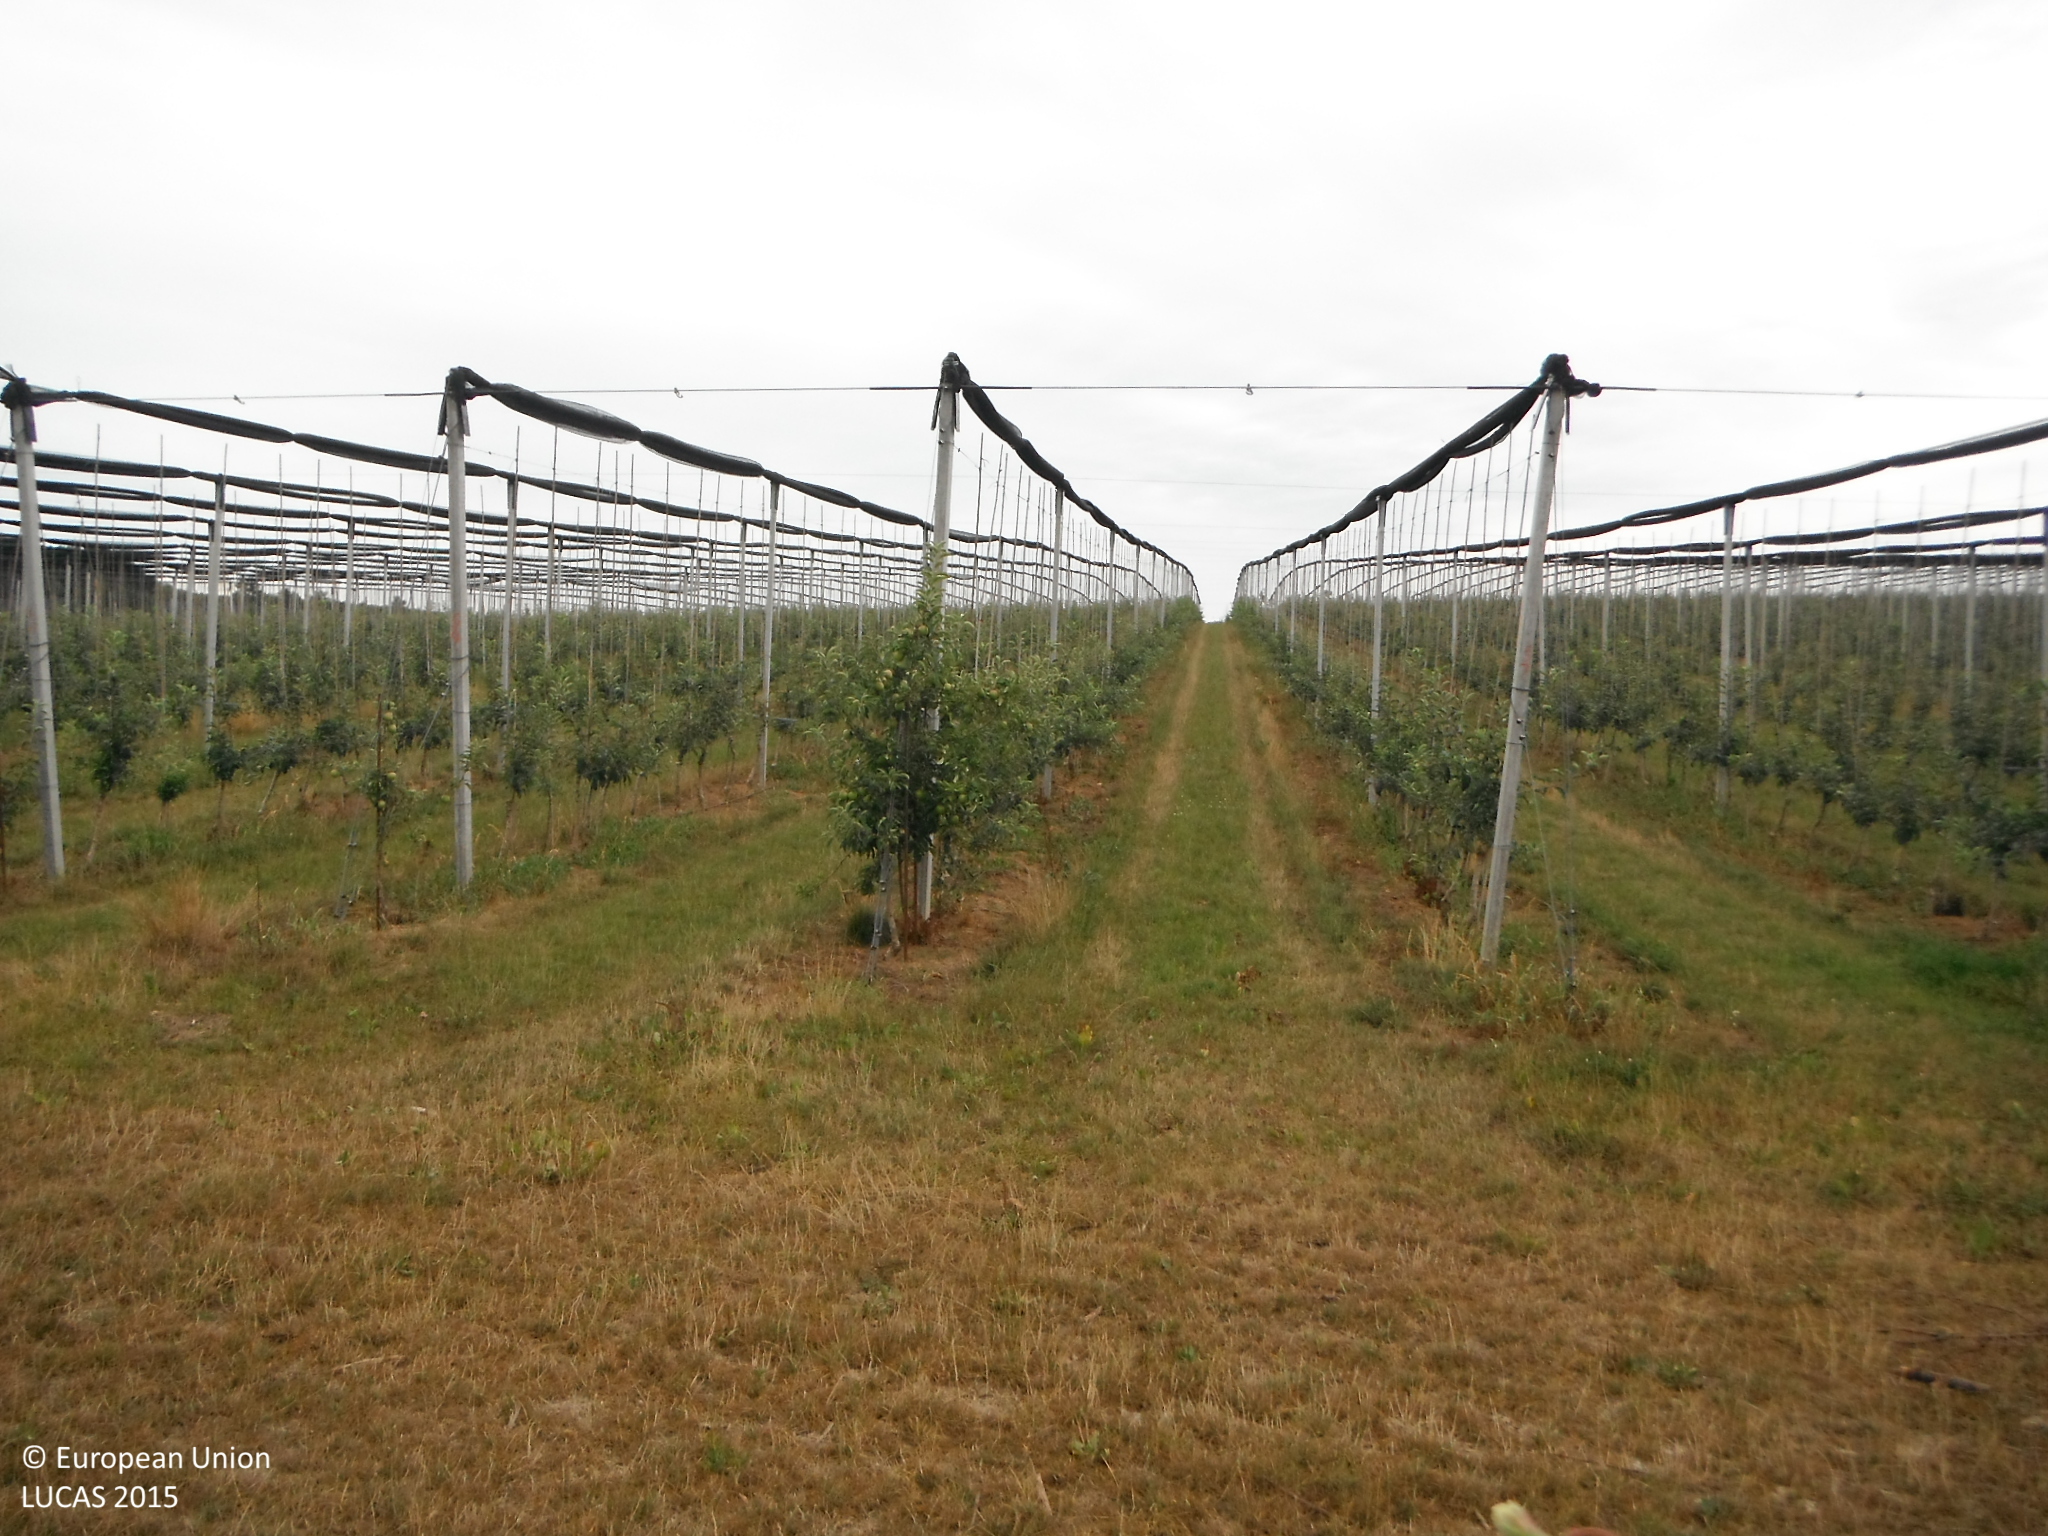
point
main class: Cropland
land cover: Permanent crops (only in case pi)
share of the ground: 50 - 75 %
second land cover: Grassland without tree/shrub cover
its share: > 75 %
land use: Agriculture (excluding fallow land and kitchen gardens)
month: July
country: SK
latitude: 48.6510
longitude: 18.3096
